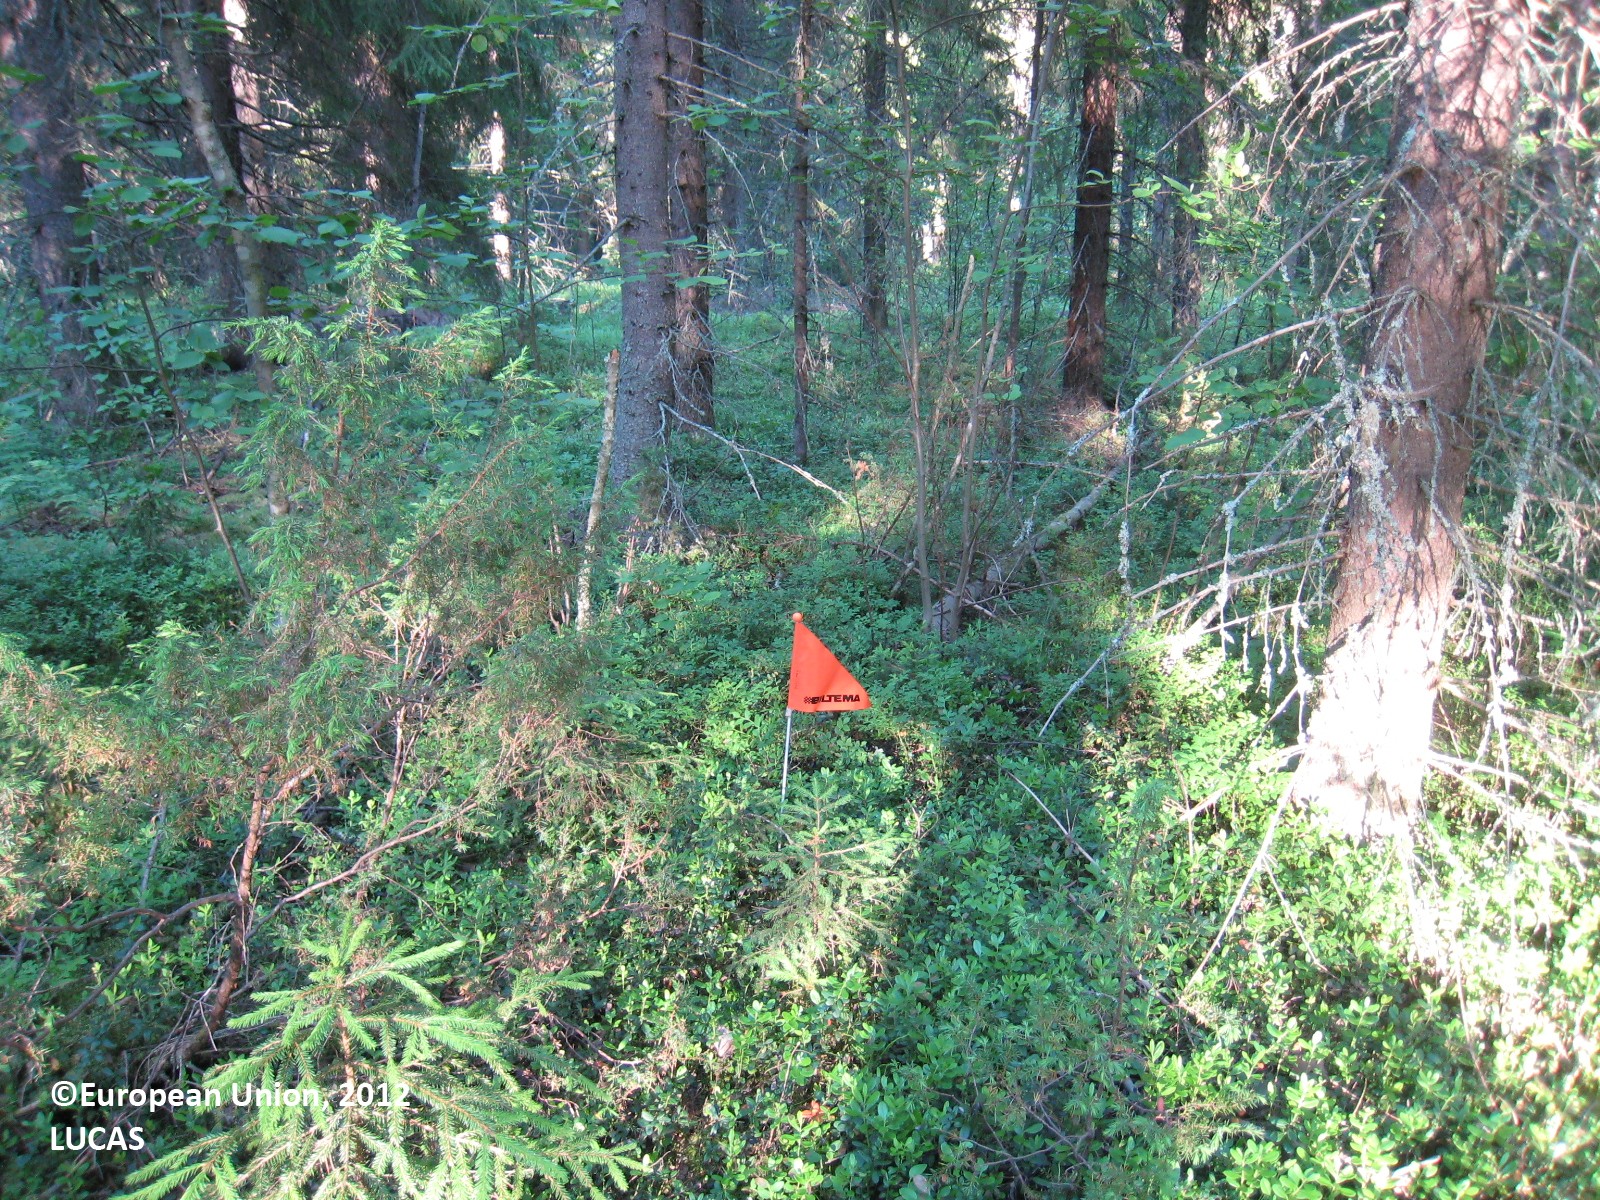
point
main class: Woodland
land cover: Other coniferous woodland
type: boreal forest
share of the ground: 50 - 75 %
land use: Forestry
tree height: > 5 m
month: June
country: FI
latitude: 62.3793
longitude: 26.4758
